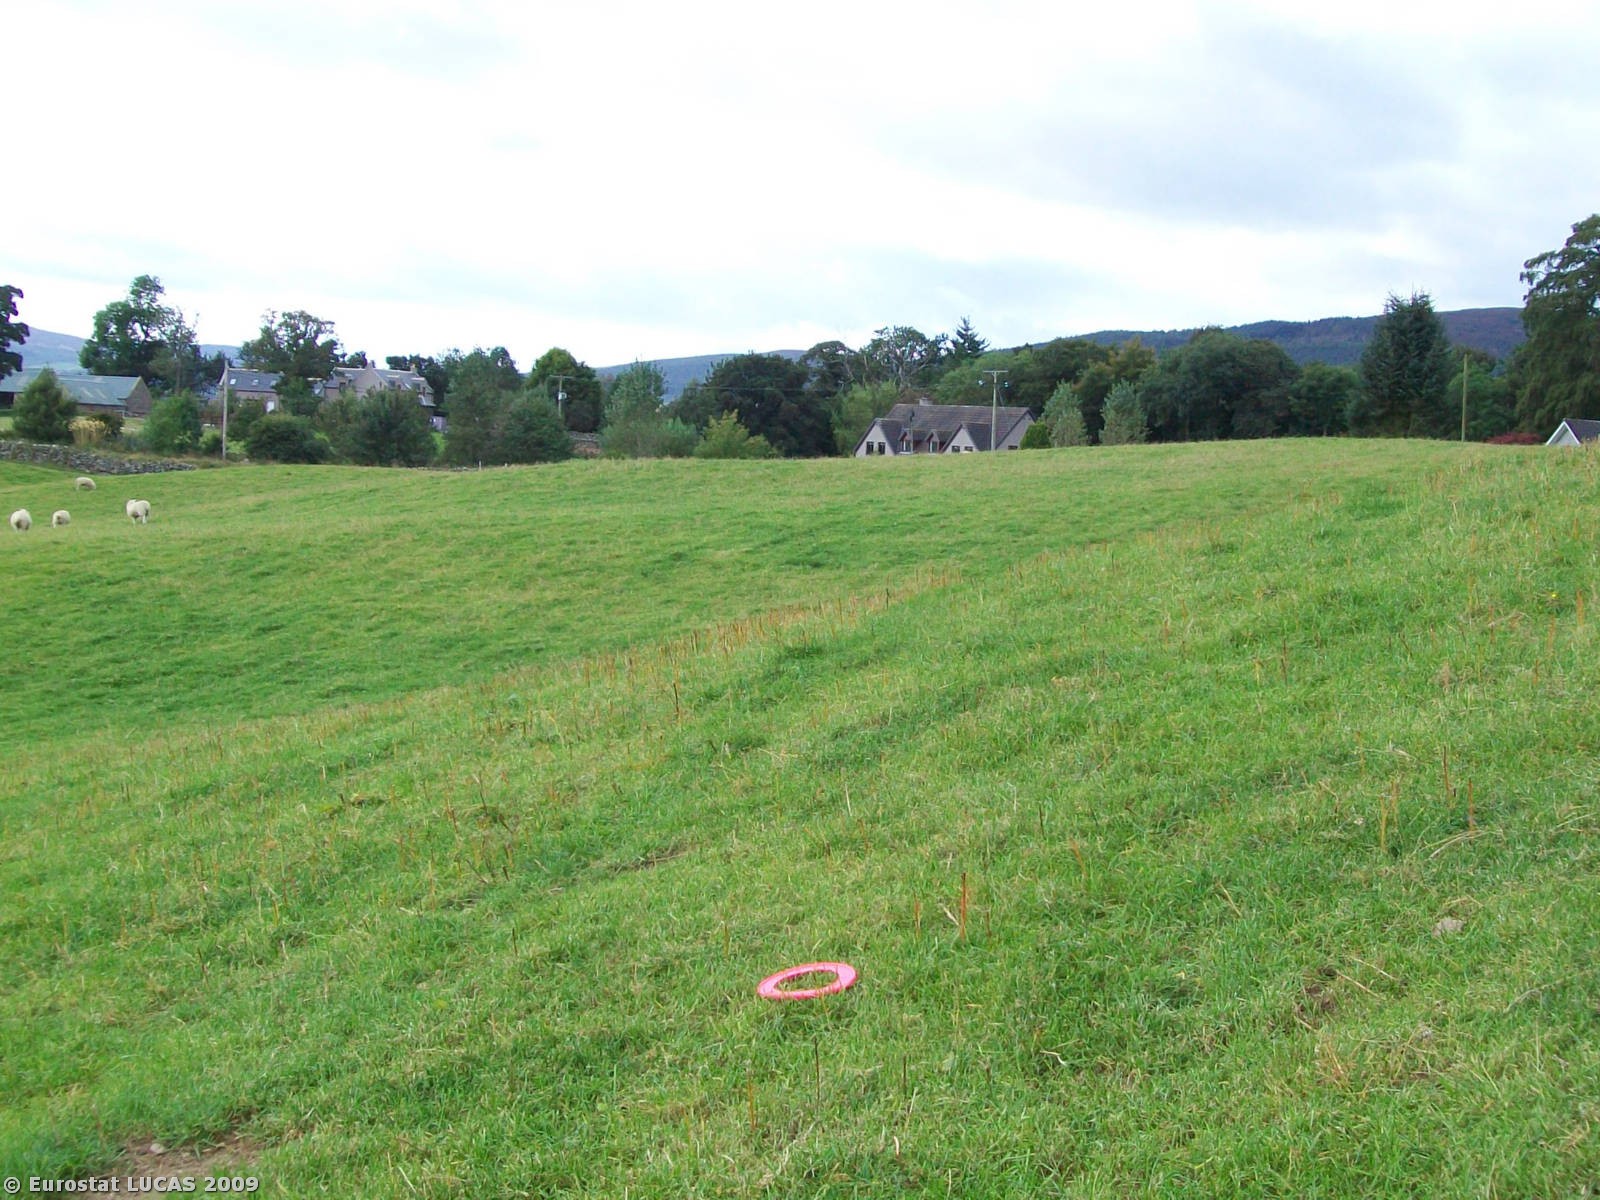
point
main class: Grassland
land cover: Grassland without tree/shrub cover
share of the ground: > 75 %
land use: Agriculture (excluding fallow land and kitchen gardens)
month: September
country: GB
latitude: 57.2500
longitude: -2.5011
